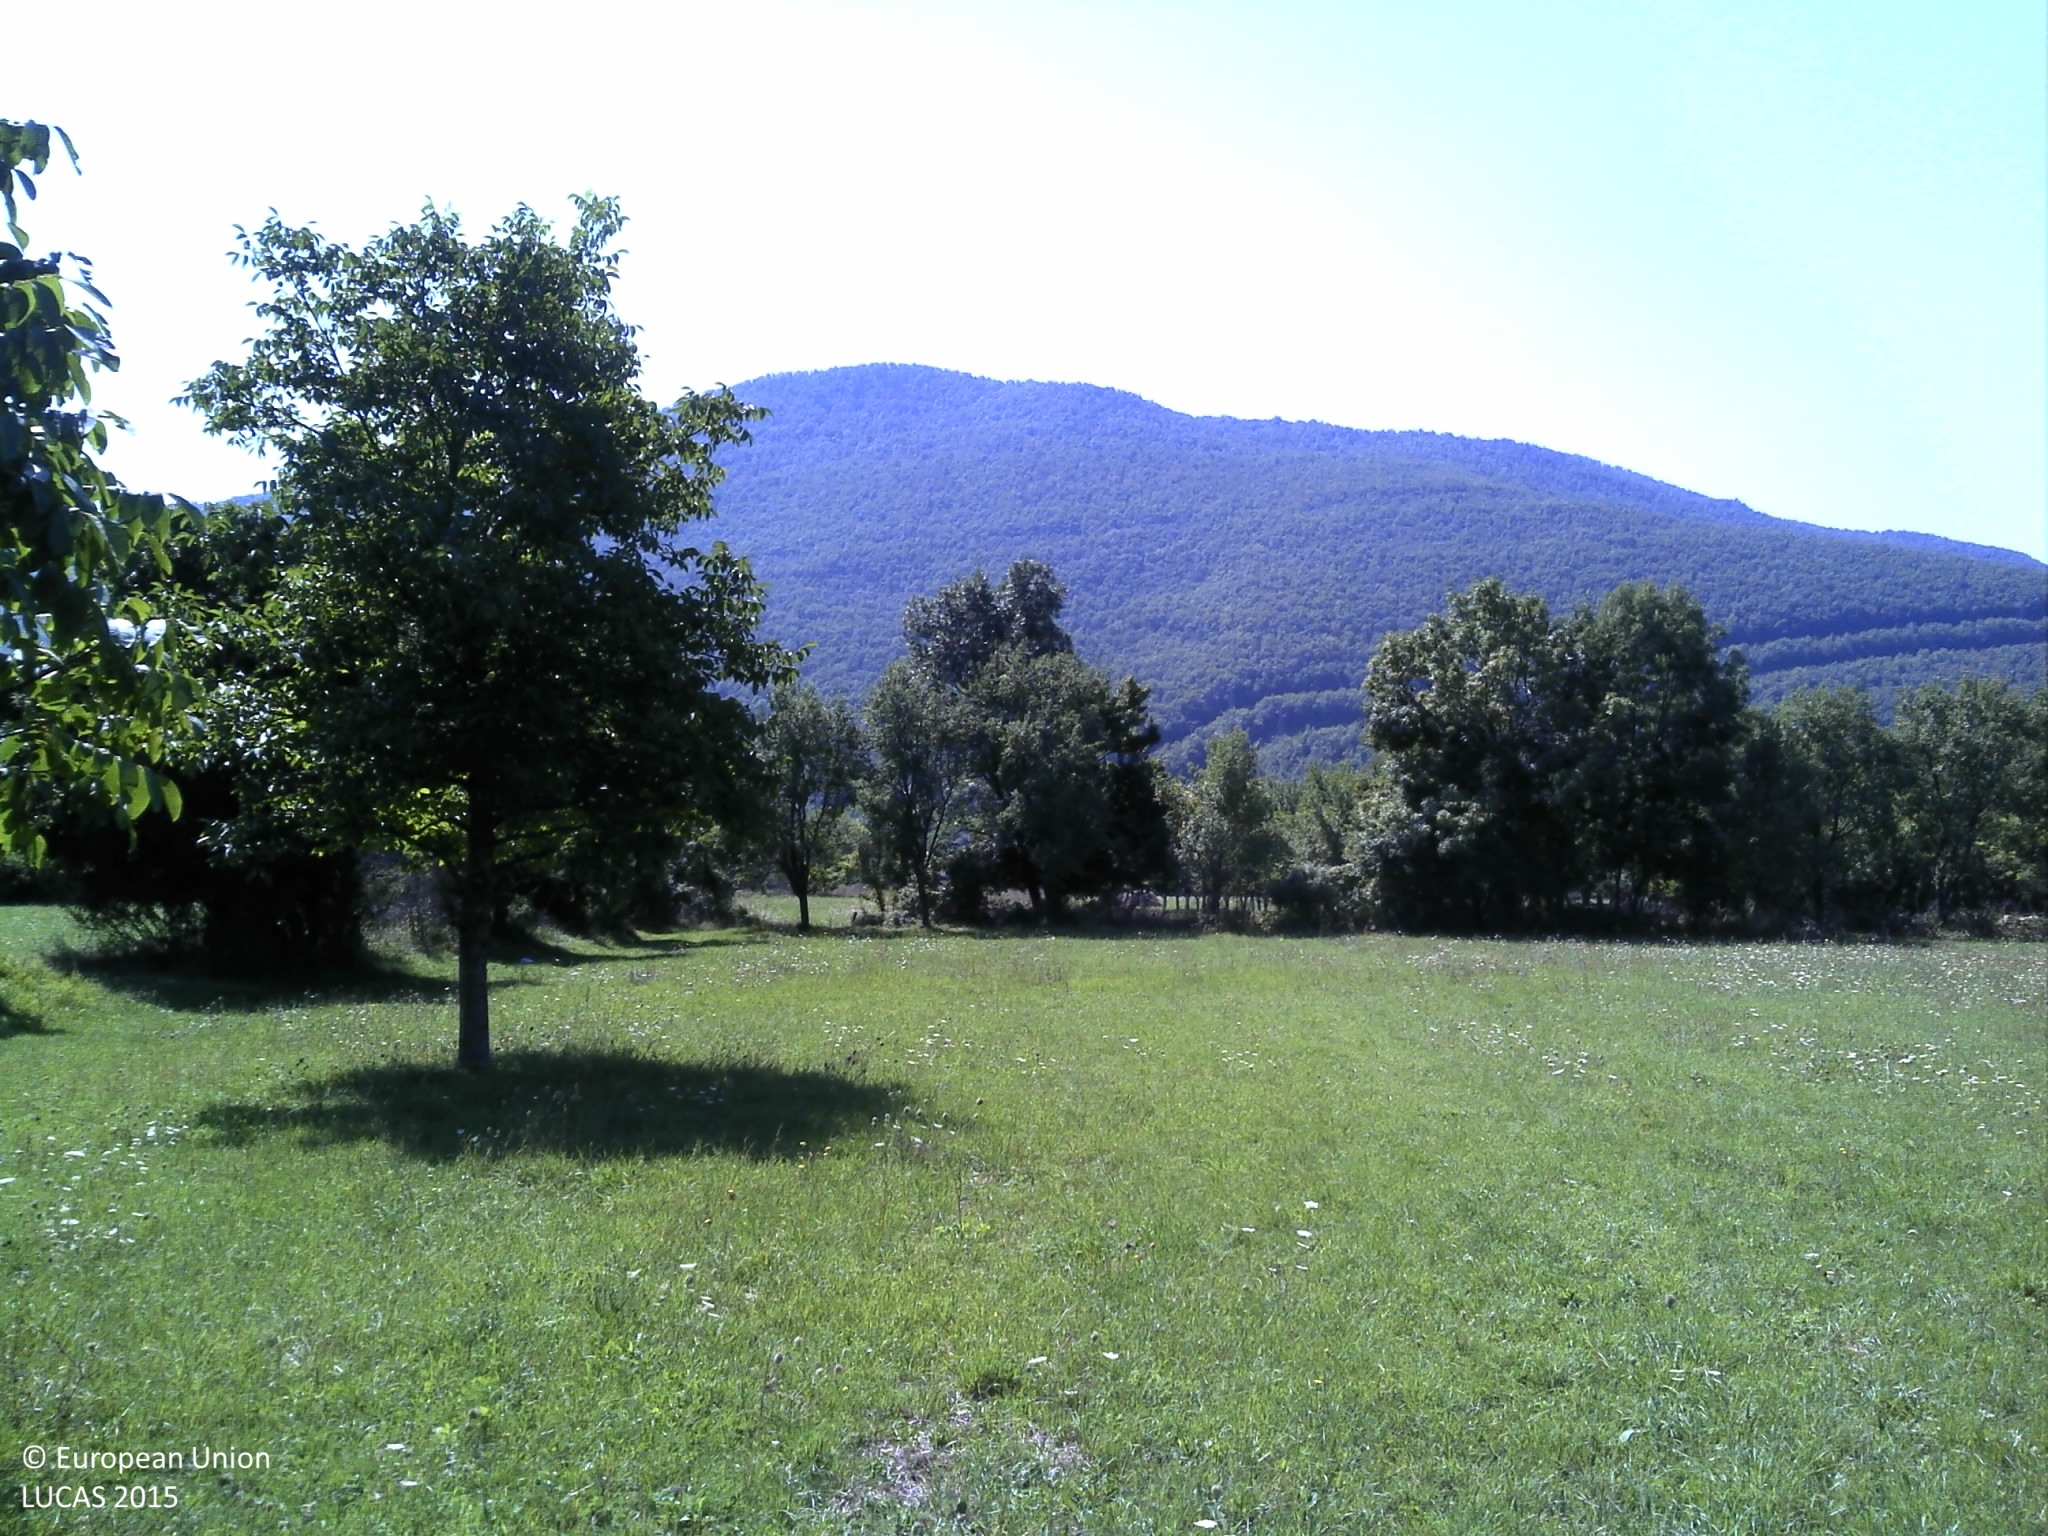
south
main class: Grassland
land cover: Grassland without tree/shrub cover
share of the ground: > 75 %
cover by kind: herbaceous plants 100 %
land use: Agriculture (excluding fallow land and kitchen gardens)
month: August
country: HR
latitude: 44.2942
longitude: 15.8459
